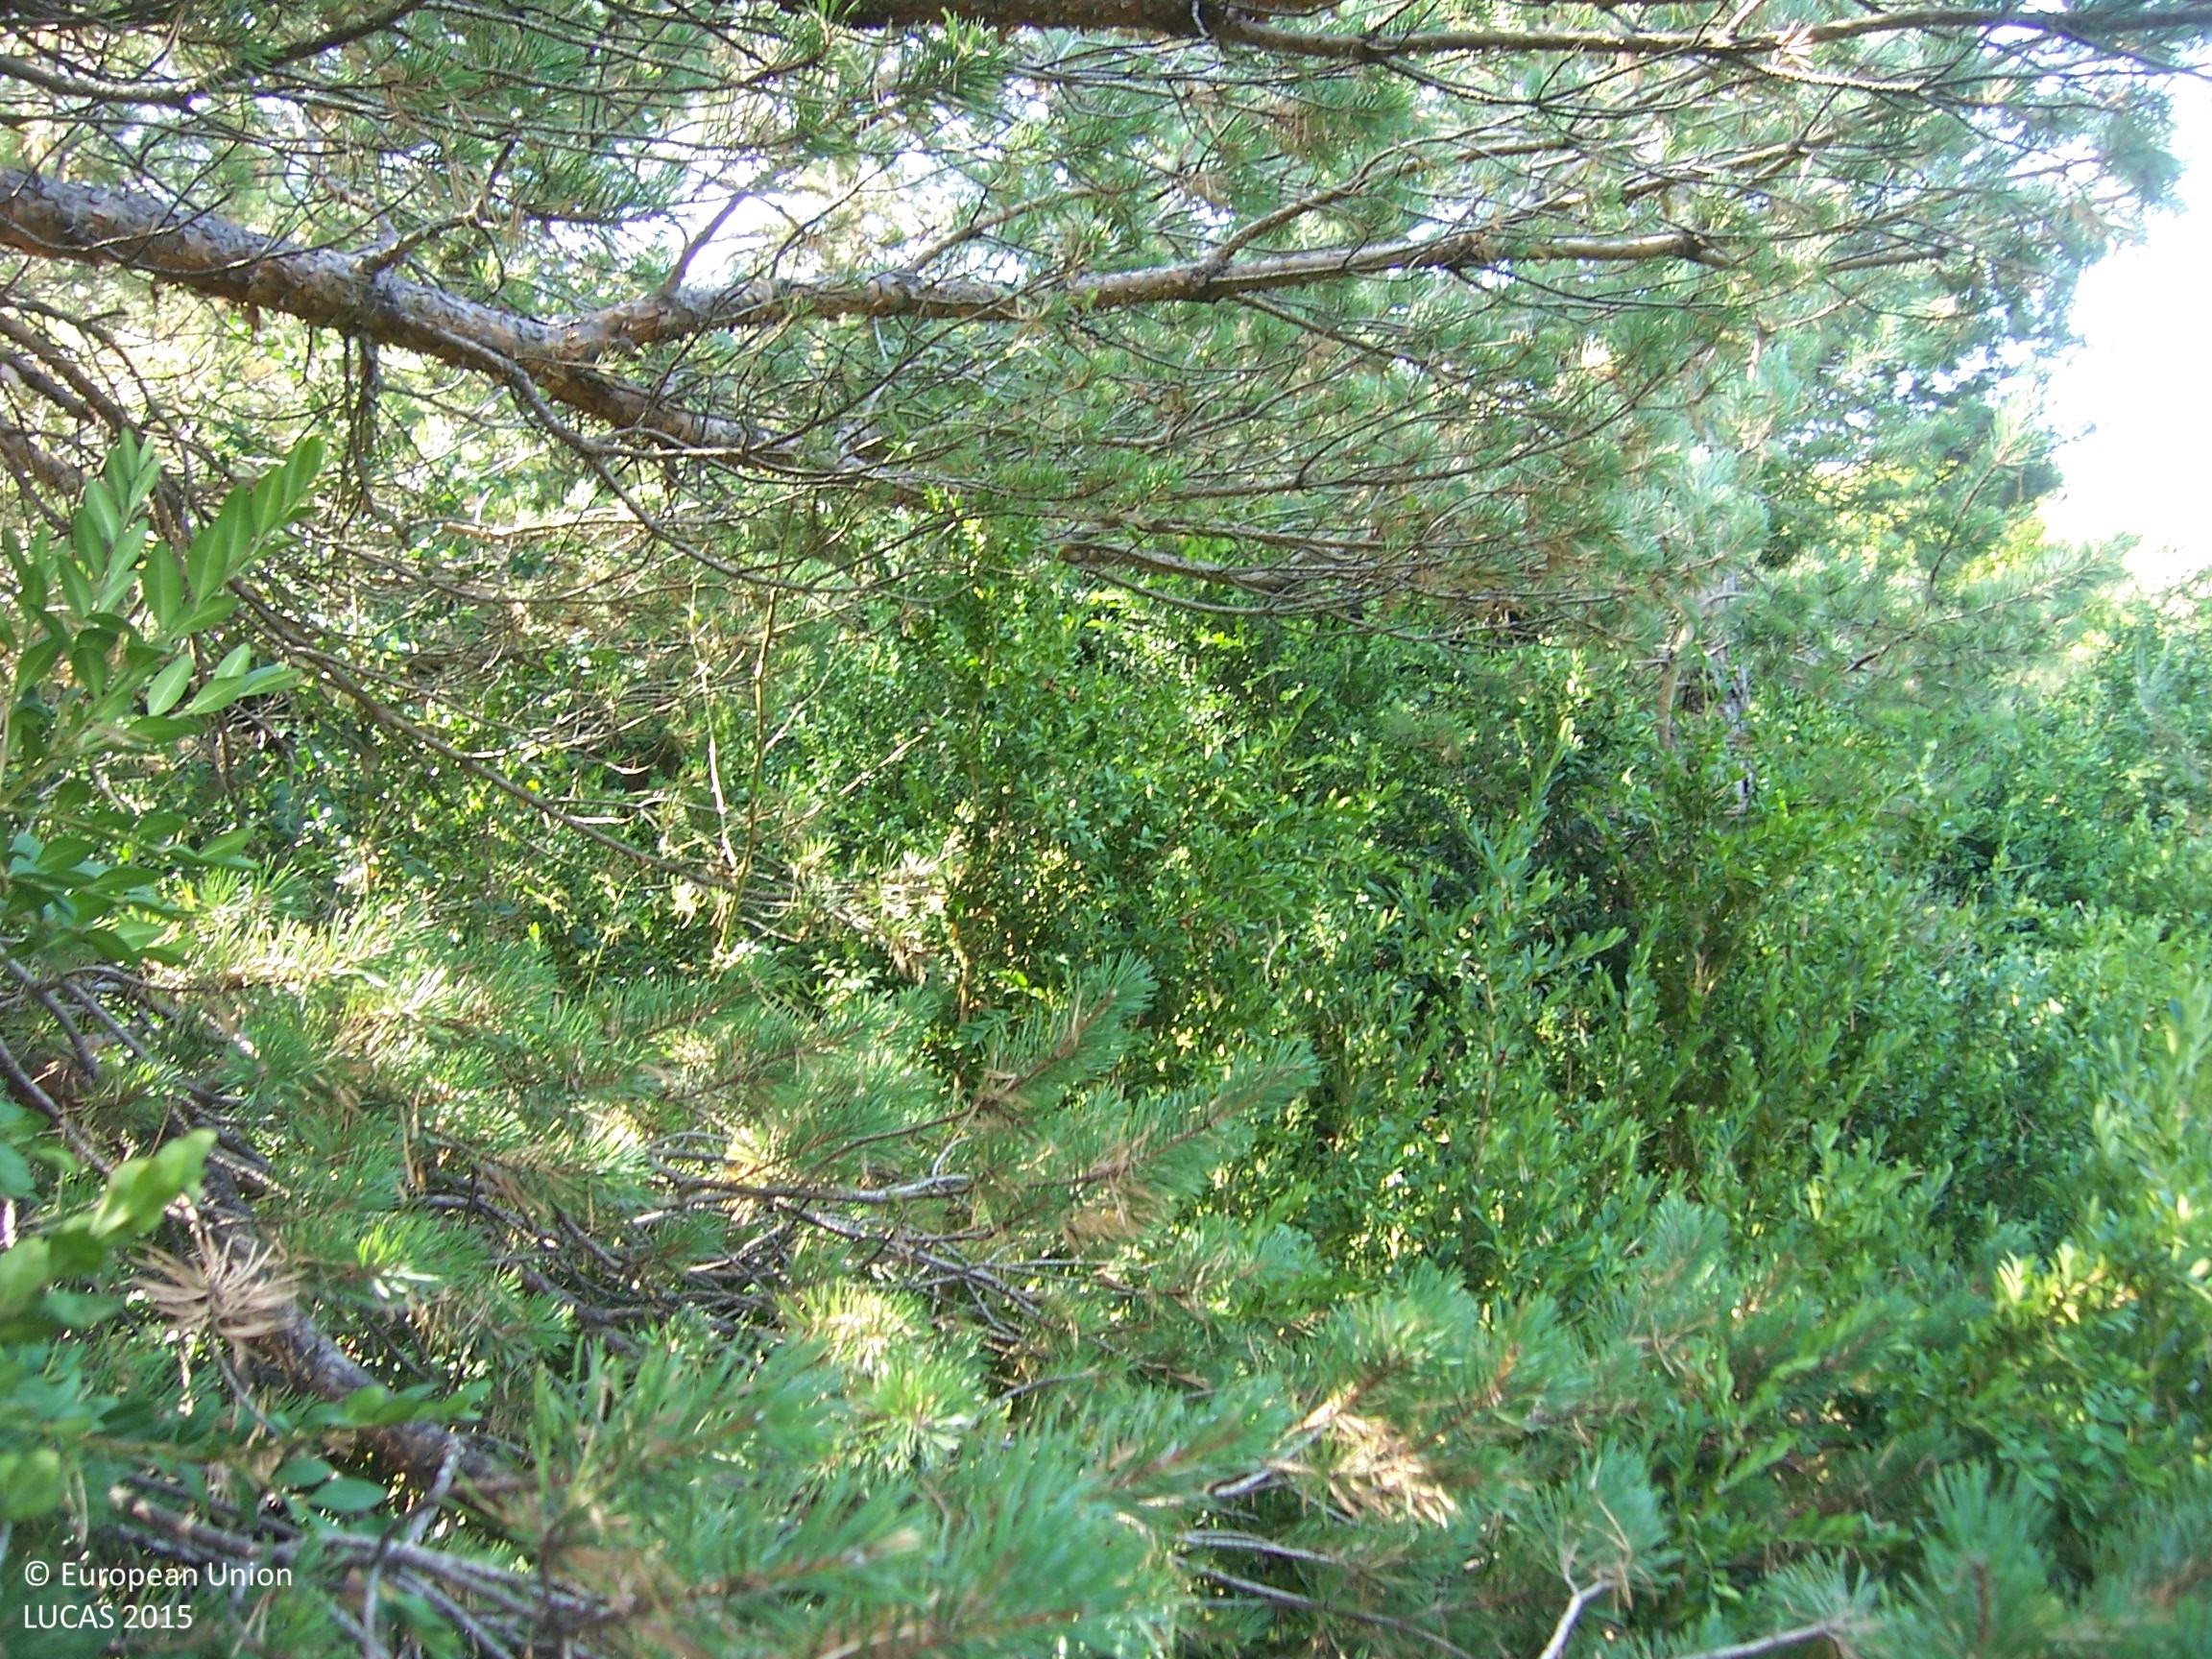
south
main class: Woodland
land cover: Pine dominated coniferous woodland
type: coniferous forest of the mediterranean region
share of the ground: > 75 %
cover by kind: coniferous forest trees 100 %
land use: Semi-natural and natural areas not in use
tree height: > 5 m
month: August
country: ES
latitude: 42.5652
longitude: -0.4658
